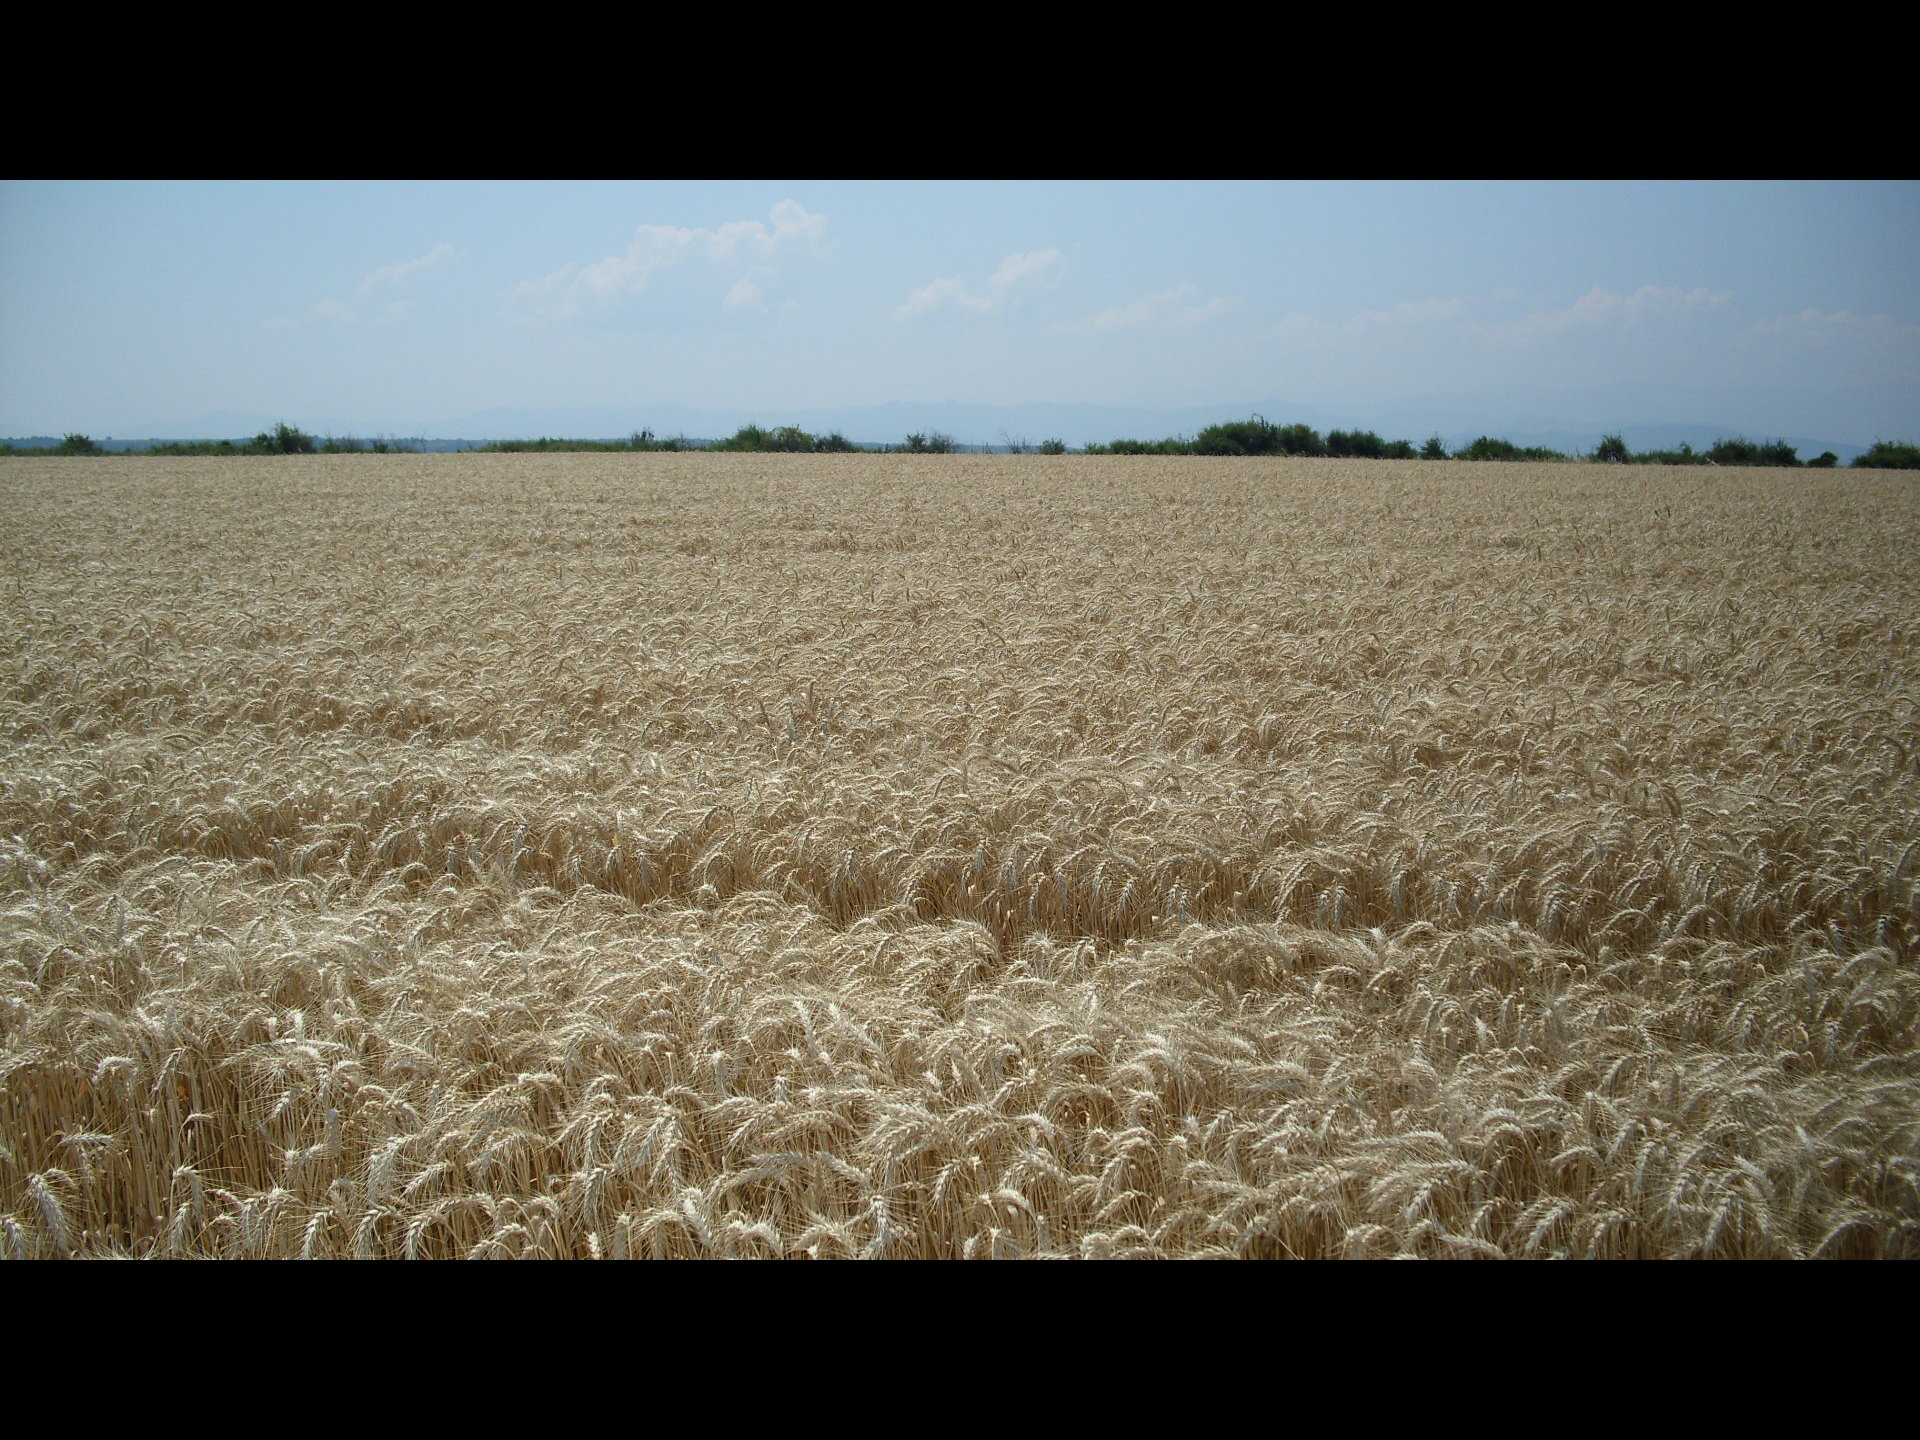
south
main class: Cropland
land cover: Common wheat
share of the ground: > 75 %
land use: Agriculture (excluding fallow land and kitchen gardens)
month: July
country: BG
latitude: 43.7019
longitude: 22.9308
